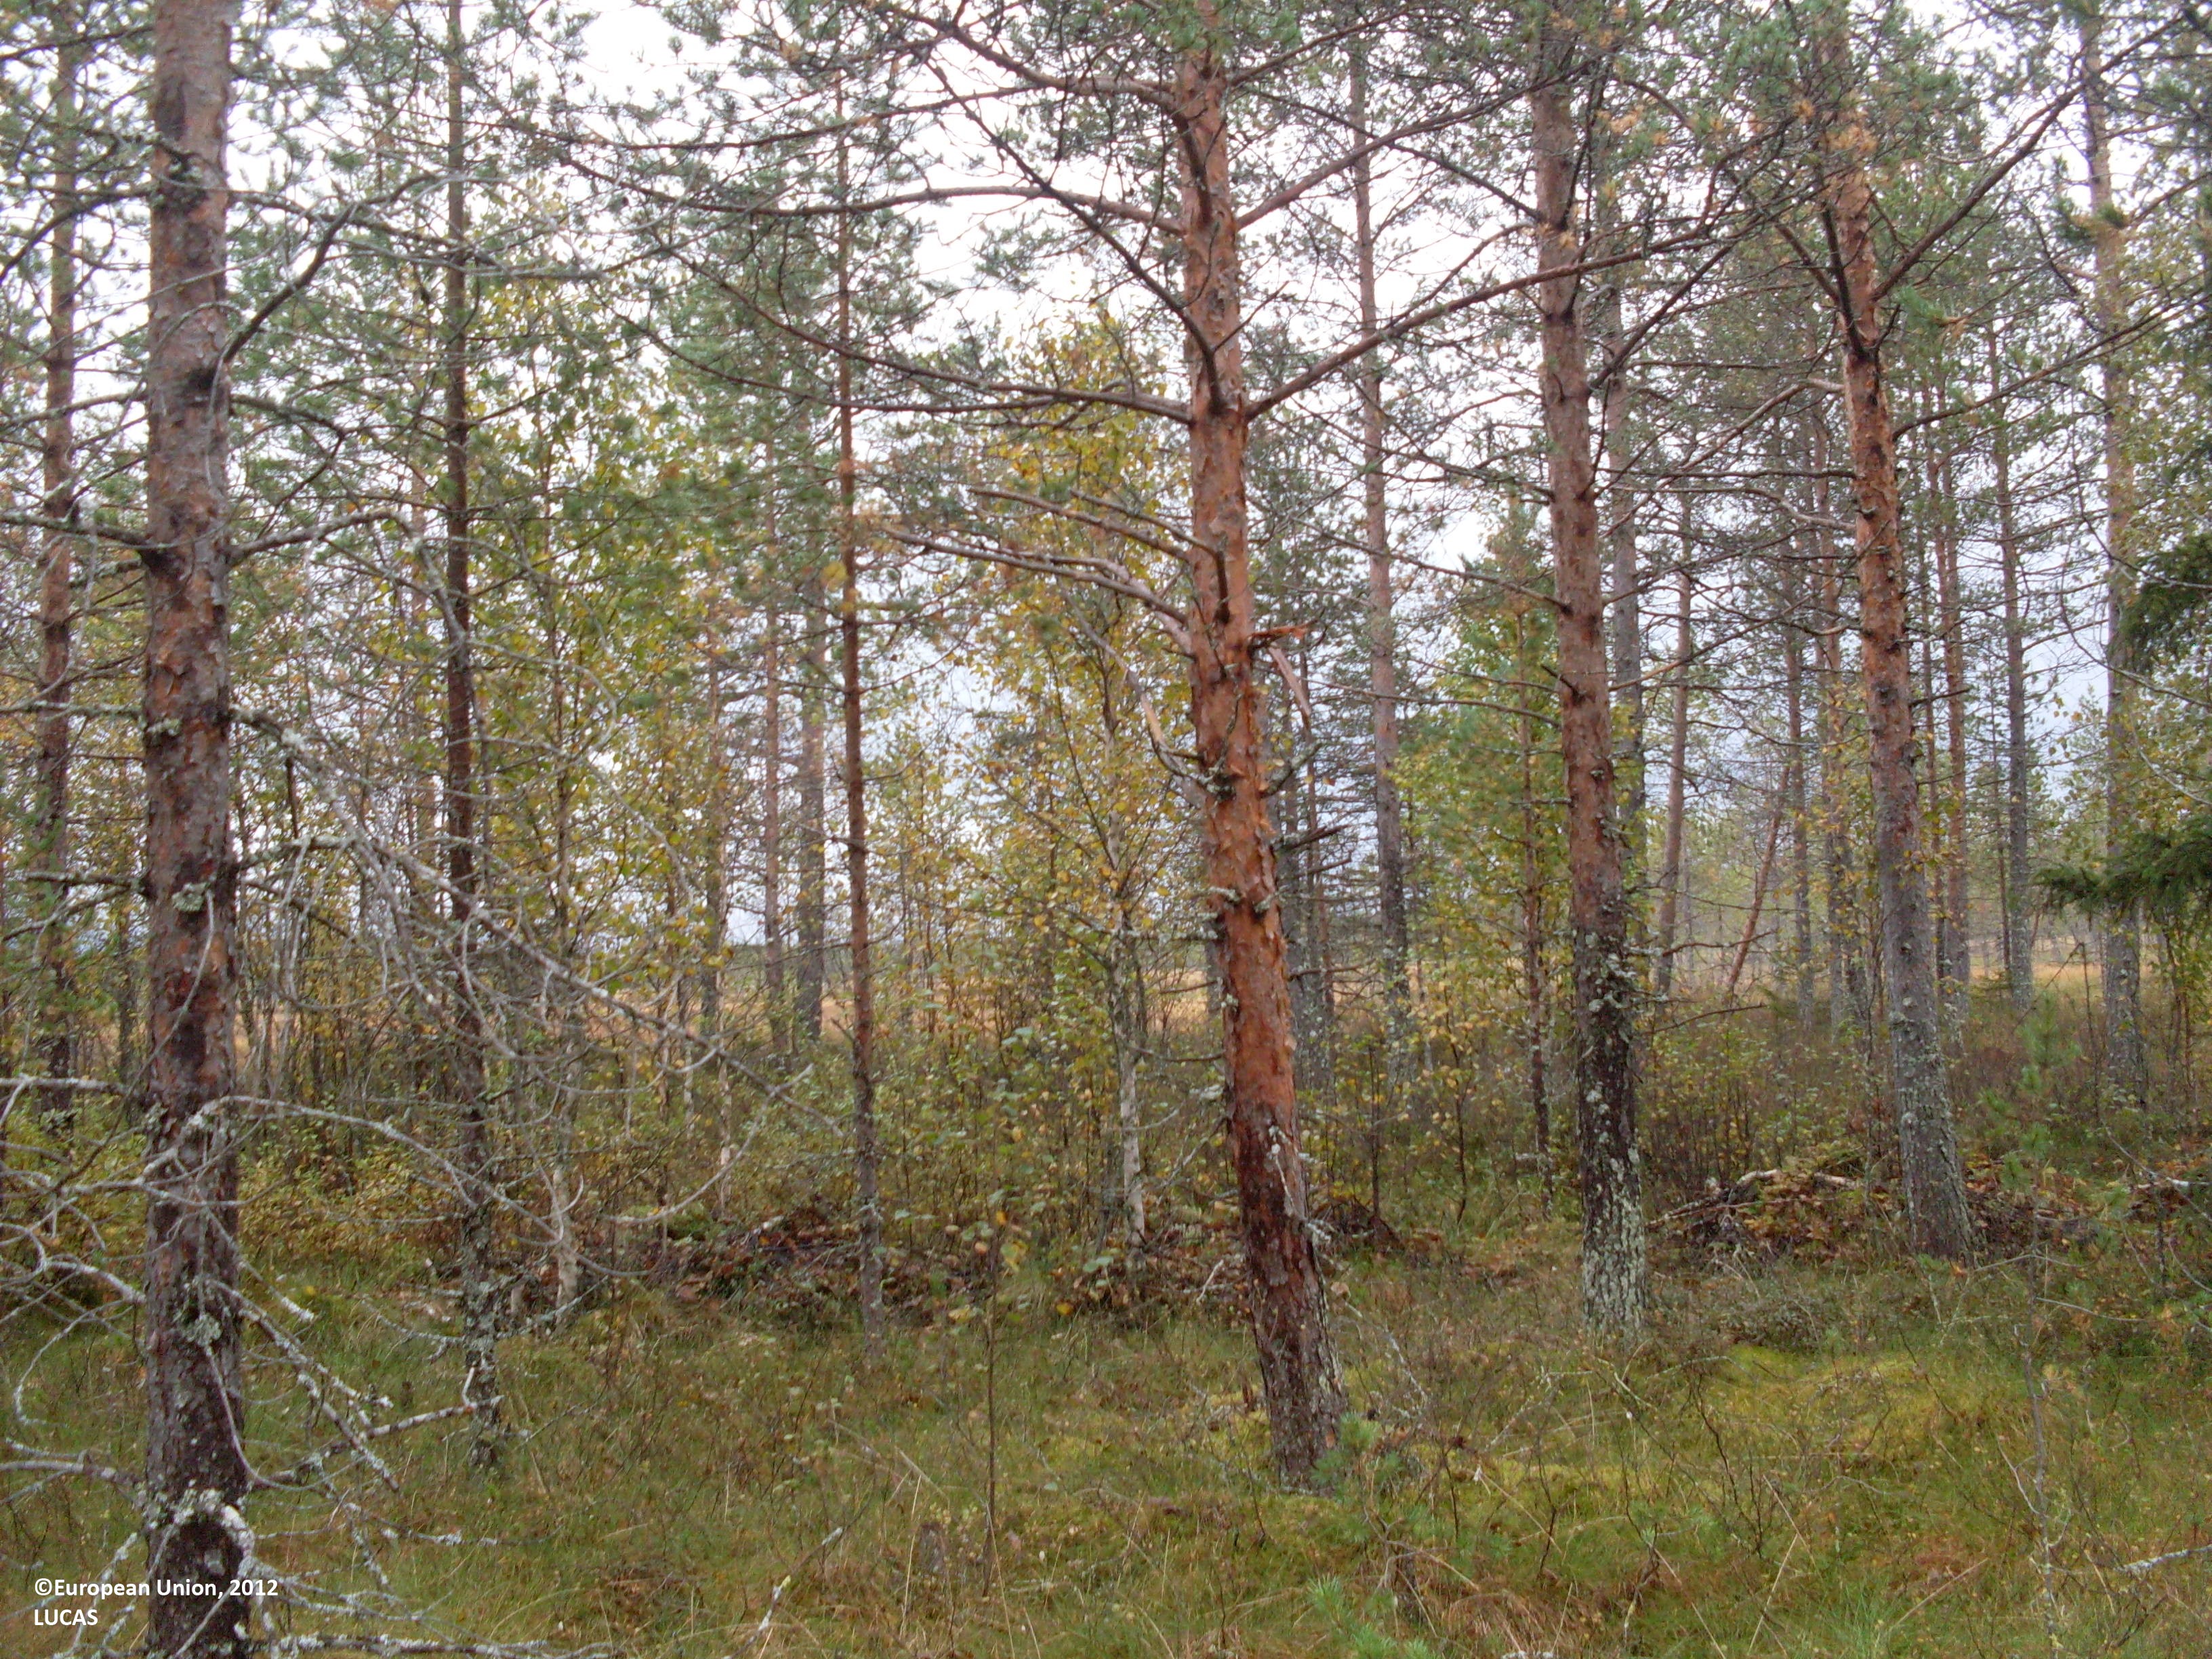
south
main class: Woodland
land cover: Other coniferous woodland
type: boreal forest
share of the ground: 50 - 75 %
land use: Forestry
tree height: > 5 m
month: September
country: FI
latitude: 64.0836
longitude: 30.2448
